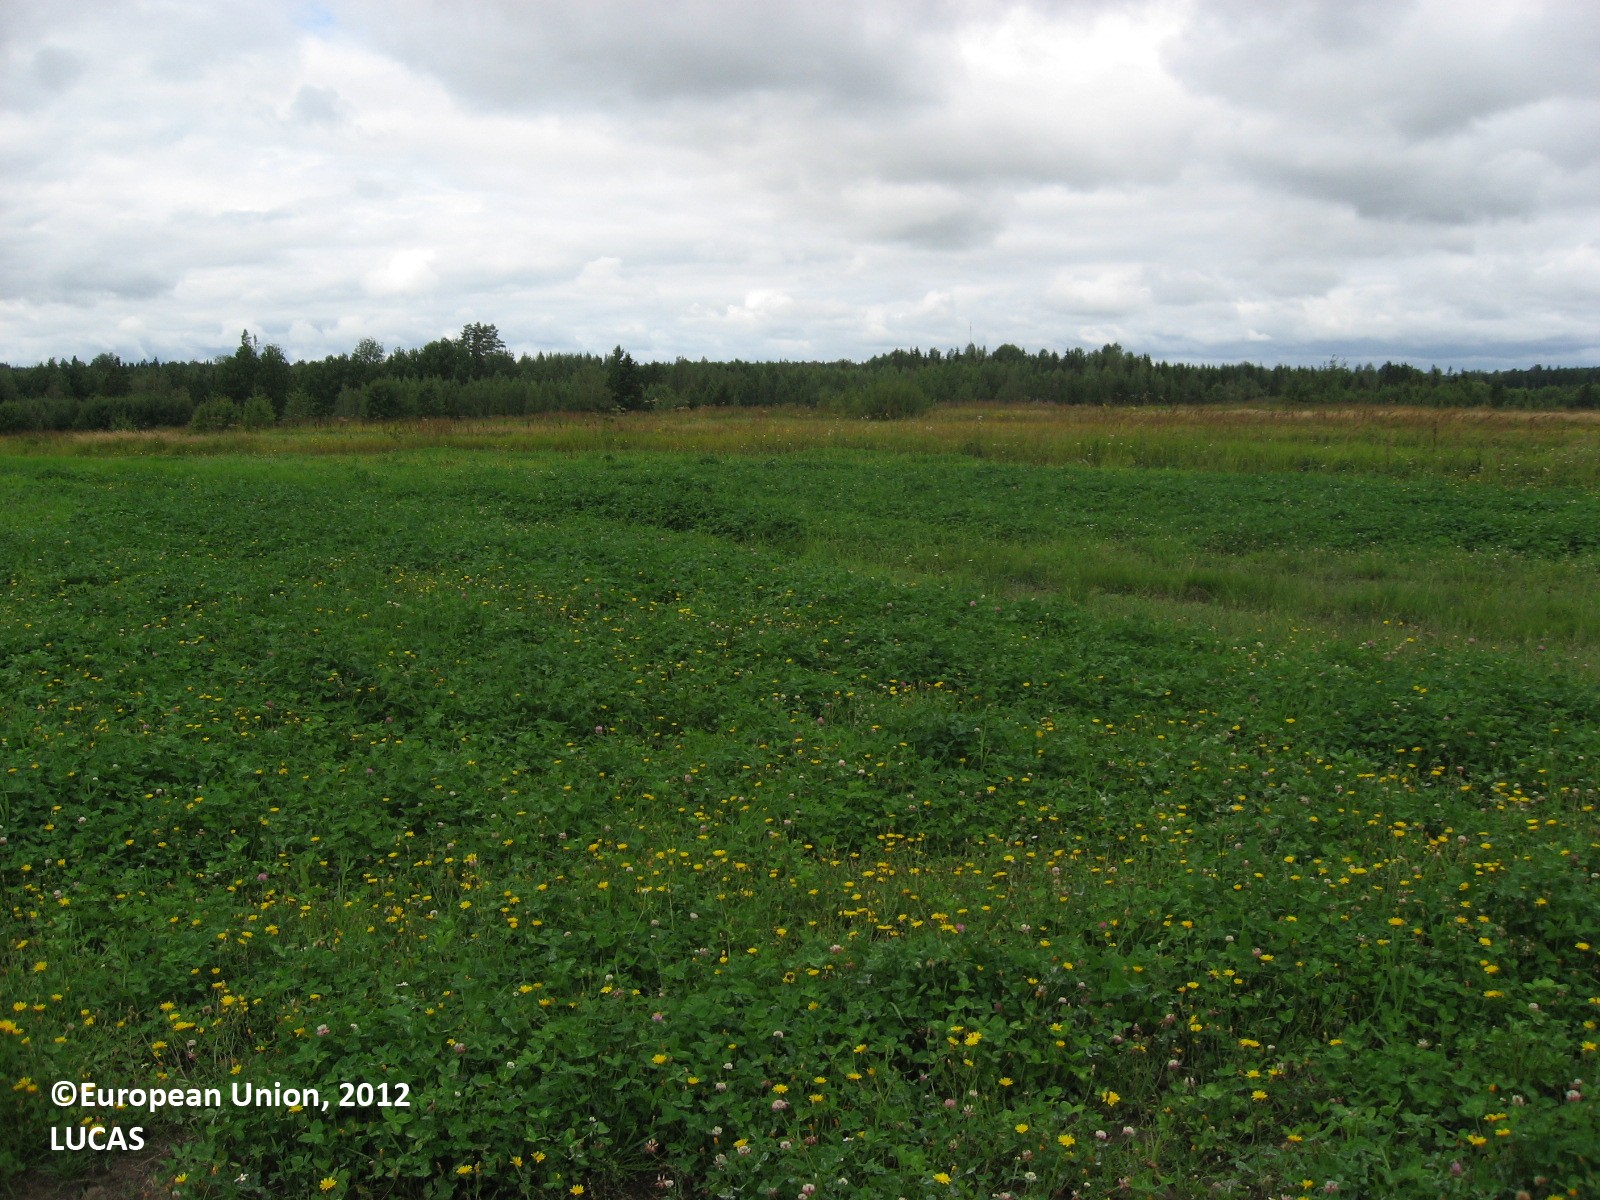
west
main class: Cropland
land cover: Clovers
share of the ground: > 75 %
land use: Agriculture (excluding fallow land and kitchen gardens)
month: August
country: FI
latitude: 60.6891
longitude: 25.5667
